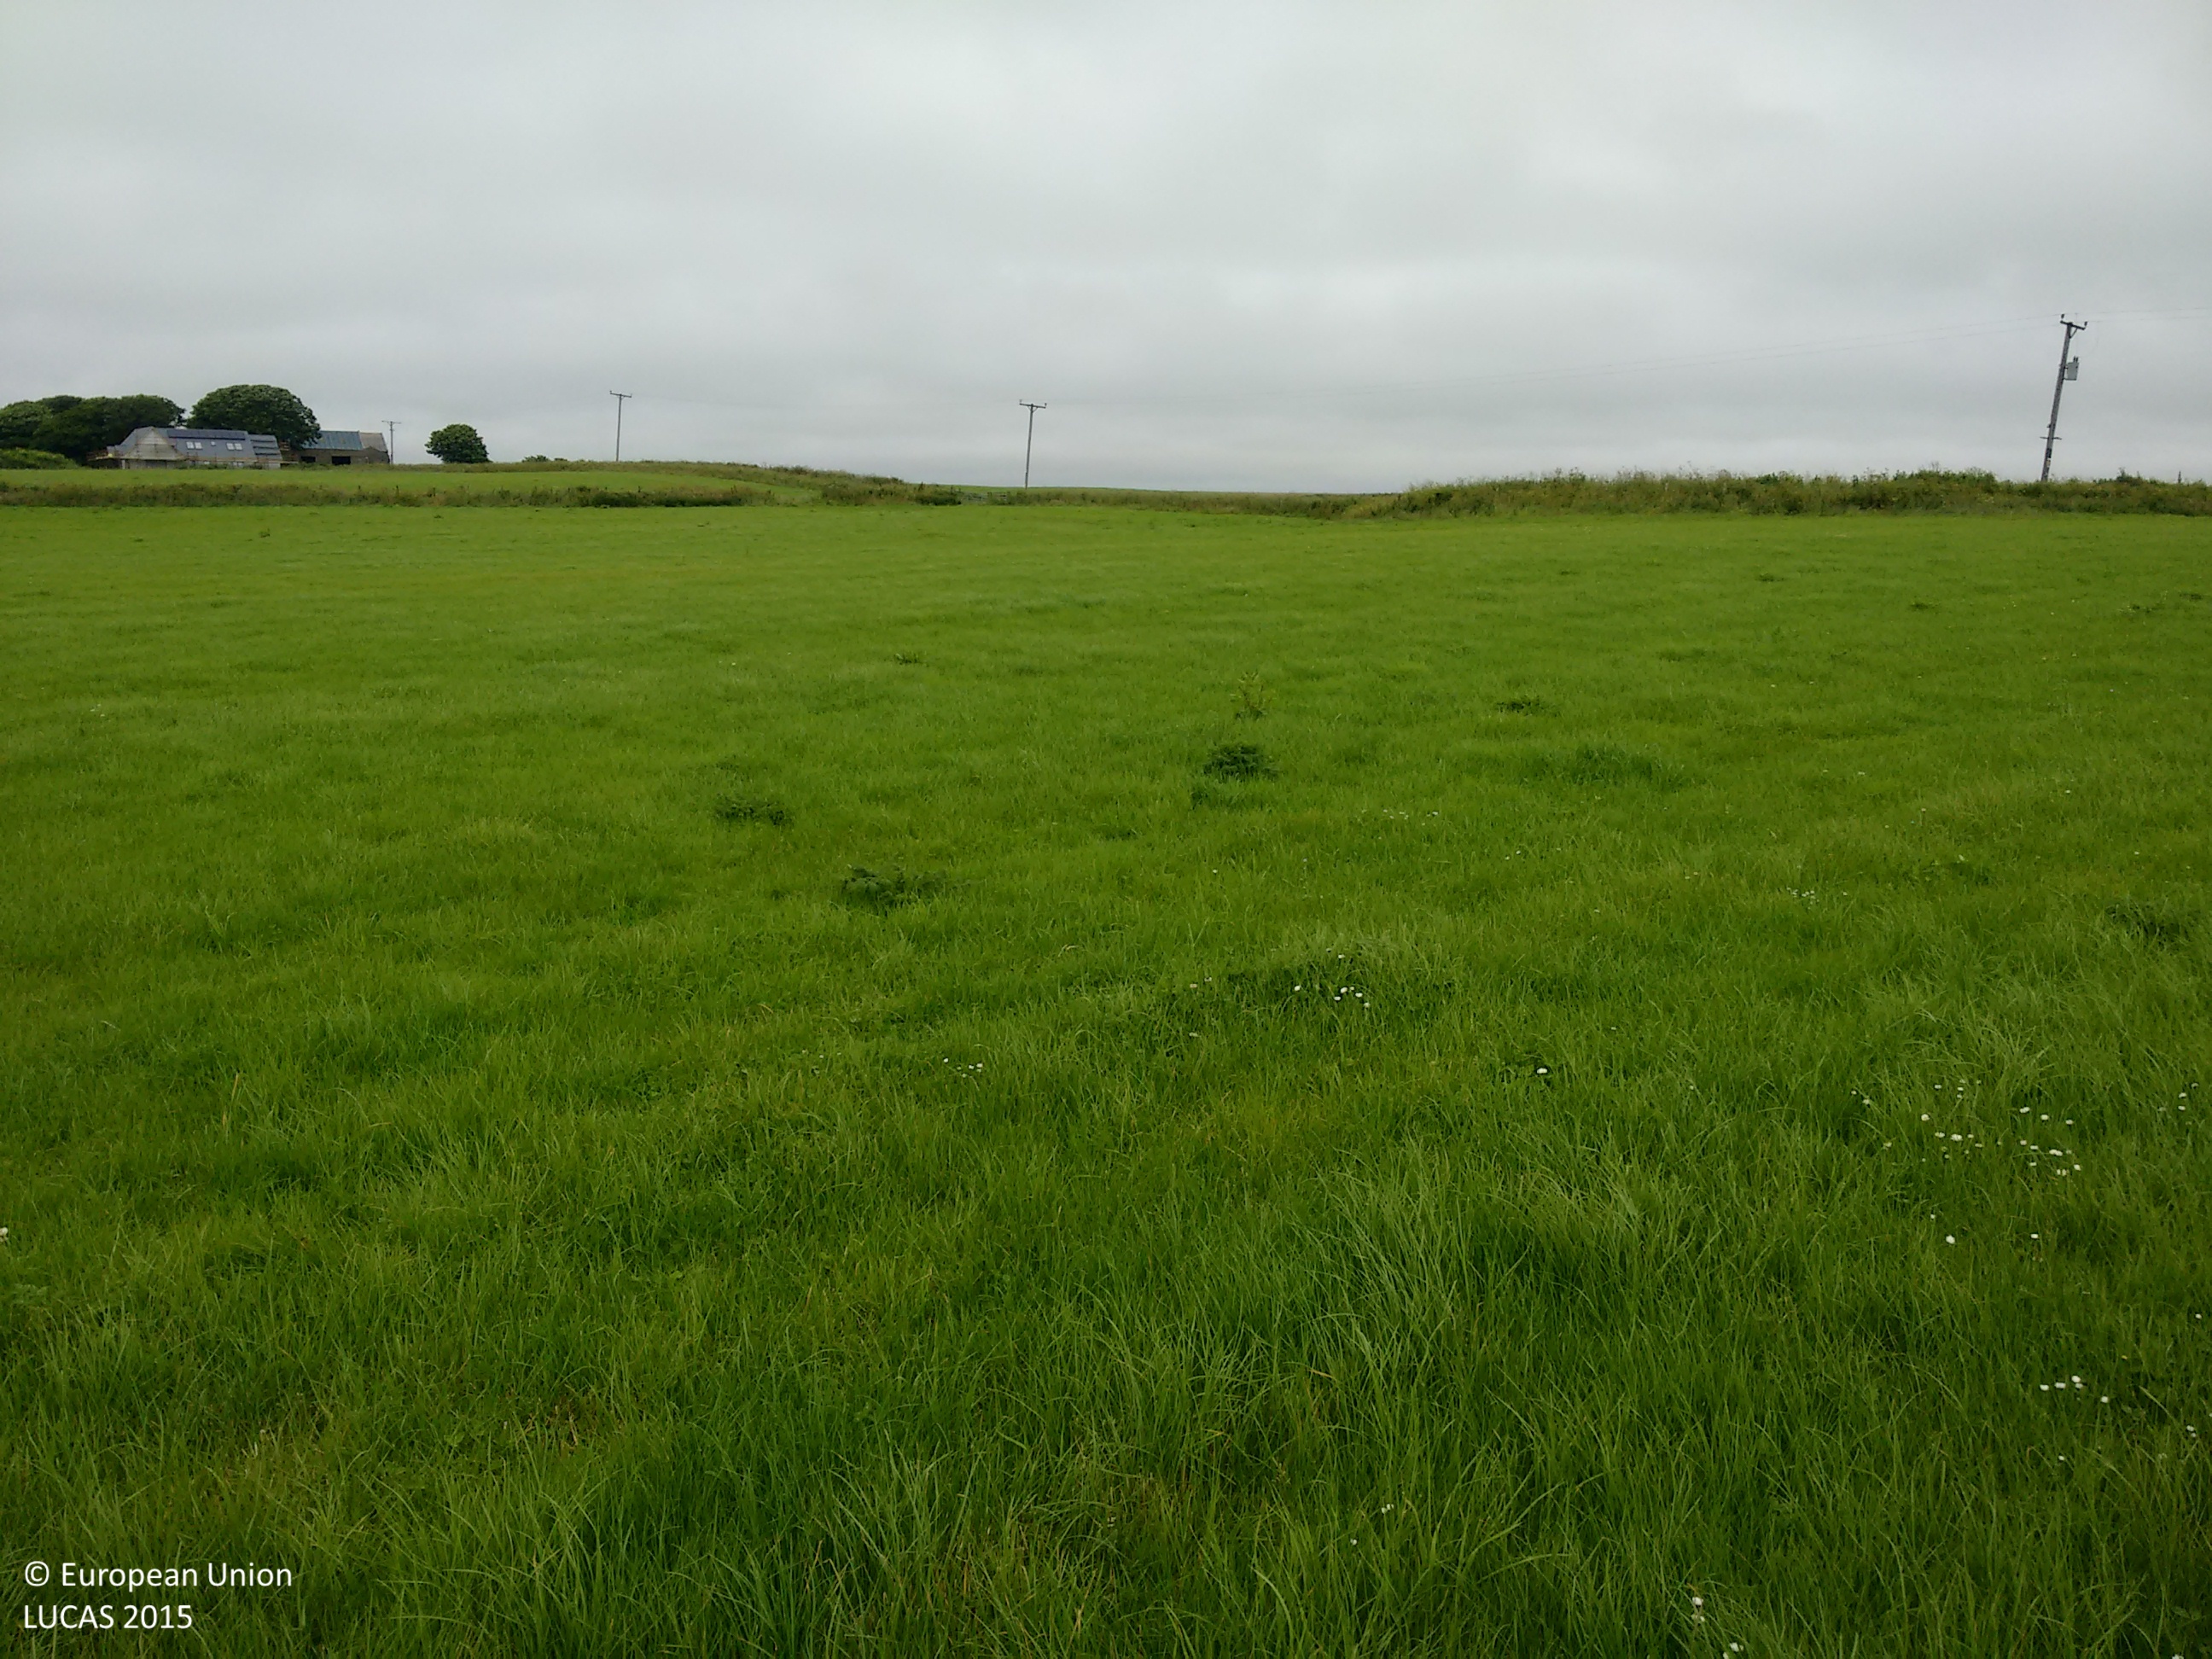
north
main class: Grassland
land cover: Grassland without tree/shrub cover
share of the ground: > 75 %
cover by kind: herbaceous plants 100 %
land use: Agriculture (excluding fallow land and kitchen gardens)
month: July
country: GB
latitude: 57.3758
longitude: -1.9357
